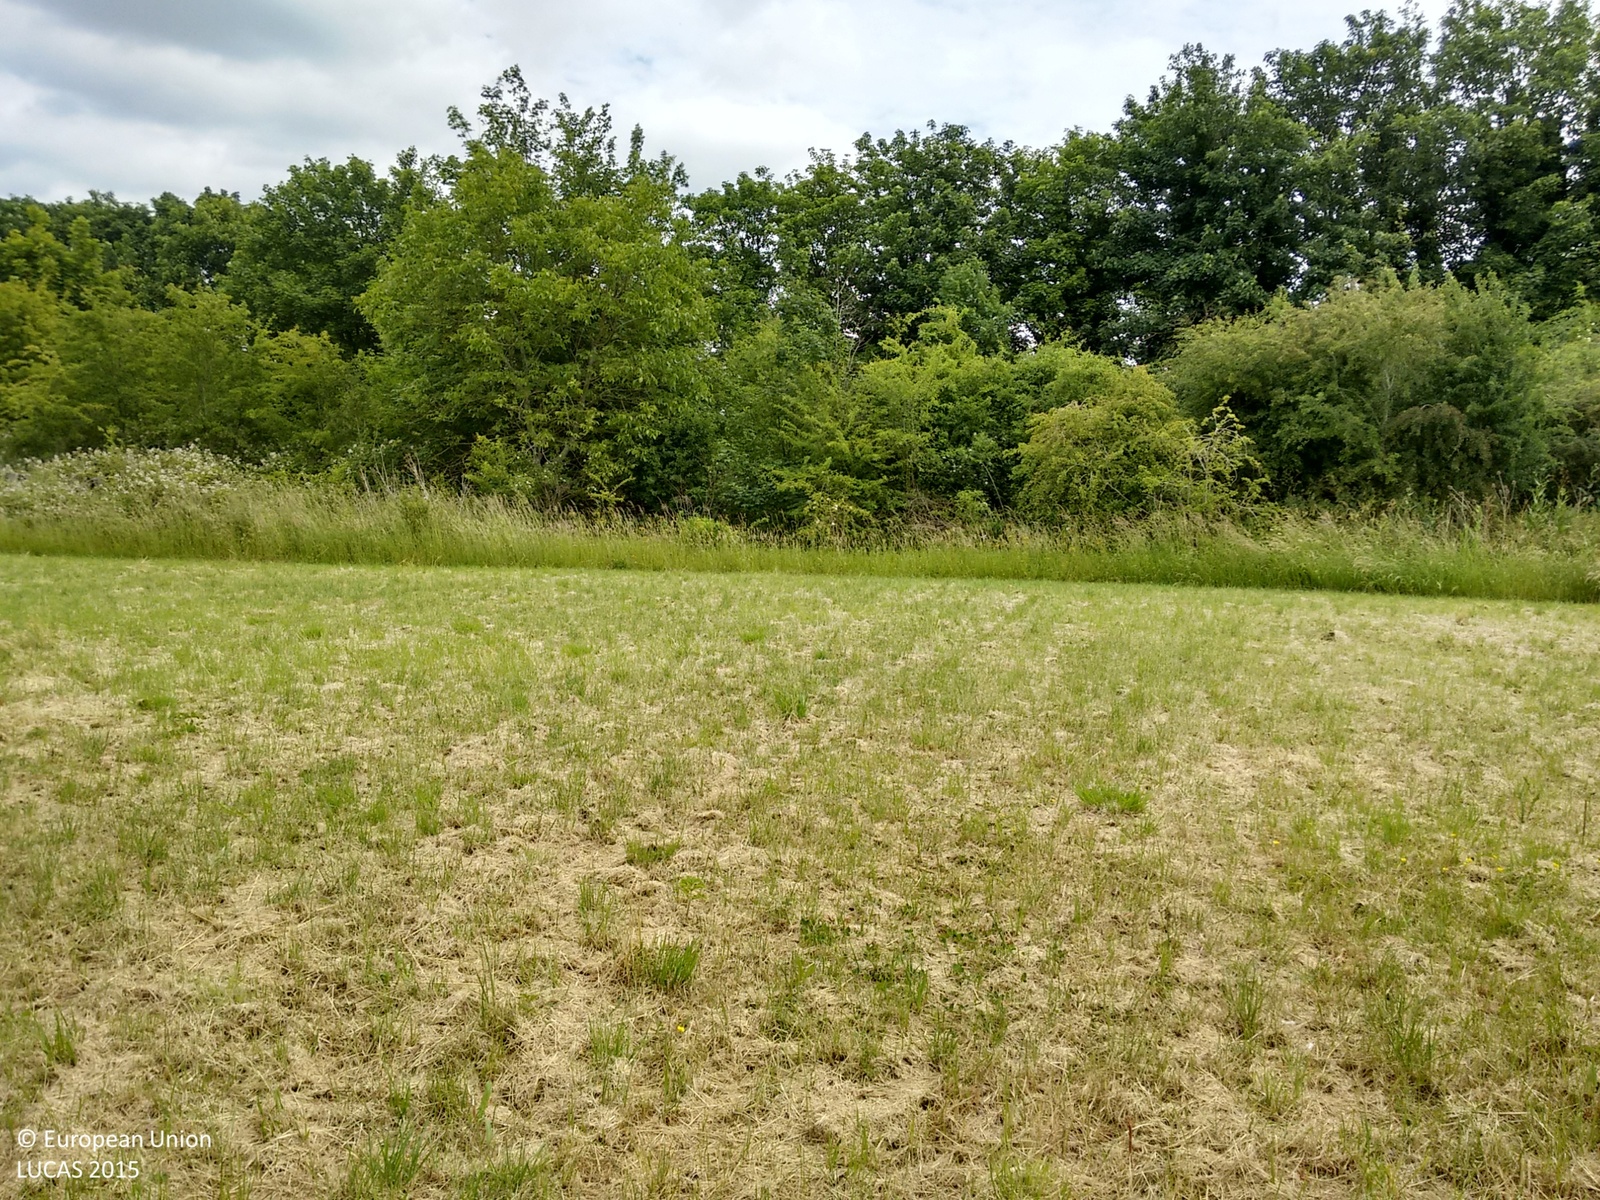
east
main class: Woodland
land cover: Broadleaved woodland
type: mesophytic deciduous forest
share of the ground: > 75 %
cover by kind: broadleaved forest trees 60 %, herbaceous plants 40 %
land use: Semi-natural and natural areas not in use
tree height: > 5 m
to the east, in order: Broadleaved woodland; Fences; Grassland without tree/shrub cover; Broadleaved woodland; Fences; Grassland without tree/shrub cover
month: June
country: GB
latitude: 51.6386
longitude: -1.2753
